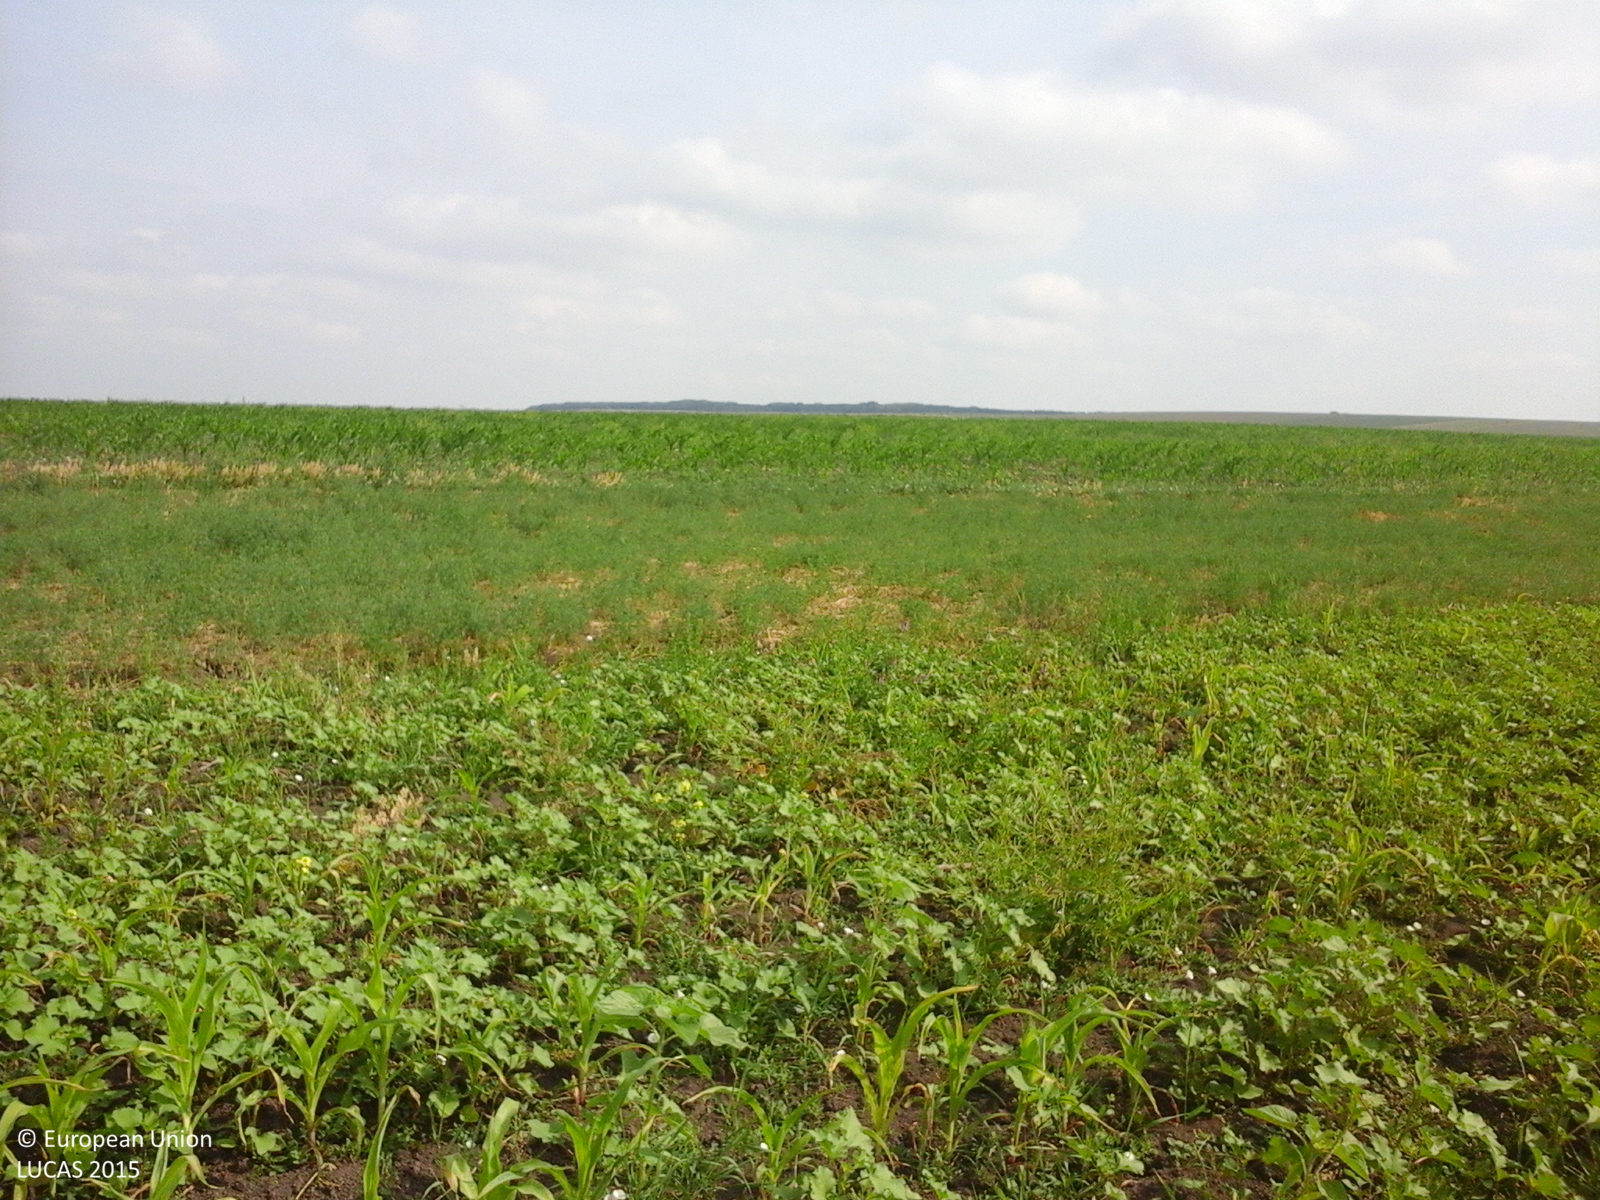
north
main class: Cropland
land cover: Maize
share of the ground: 25 - 50 %
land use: Agriculture (excluding fallow land and kitchen gardens)
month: June
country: RO
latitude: 47.7174
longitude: 26.8839
